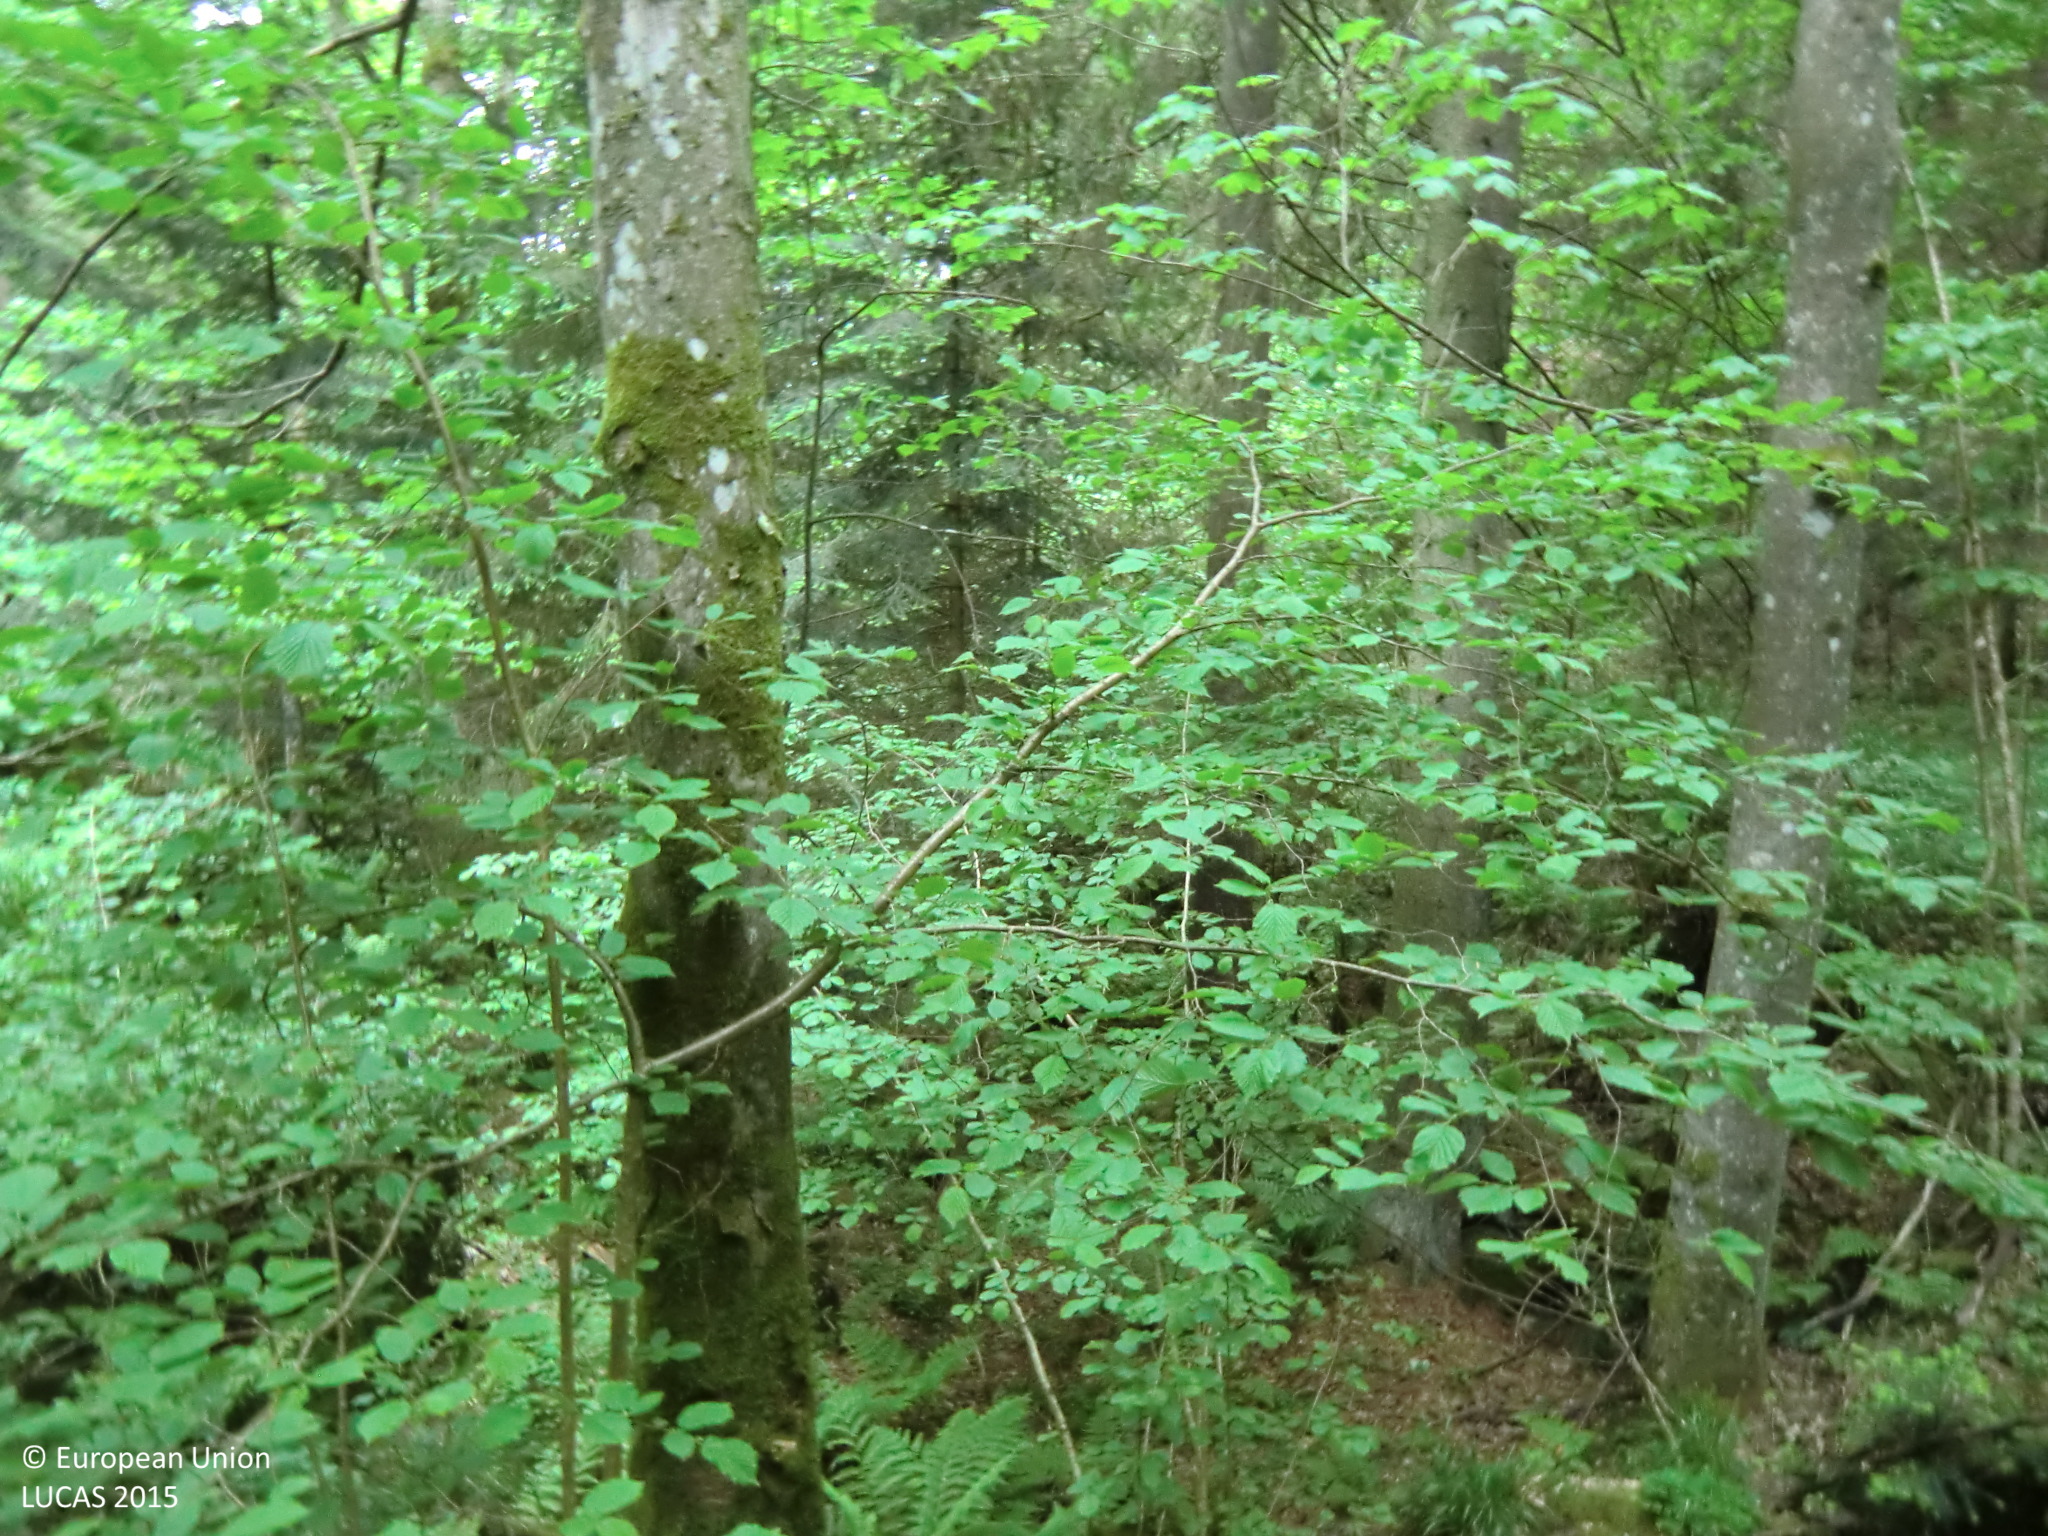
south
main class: Woodland
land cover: Spruce dominated mixed woodland
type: hemiboreal forest and nemoral coniferous forest and mixed broadleaved-coniferous forest
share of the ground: > 75 %
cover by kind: coniferous forest trees 40 %, broadleaved forest trees 40 %, shrubs 10 %, herbaceous plants 10 %
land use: Forestry
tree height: > 5 m
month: May
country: AT
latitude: 48.3646
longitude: 14.9550
